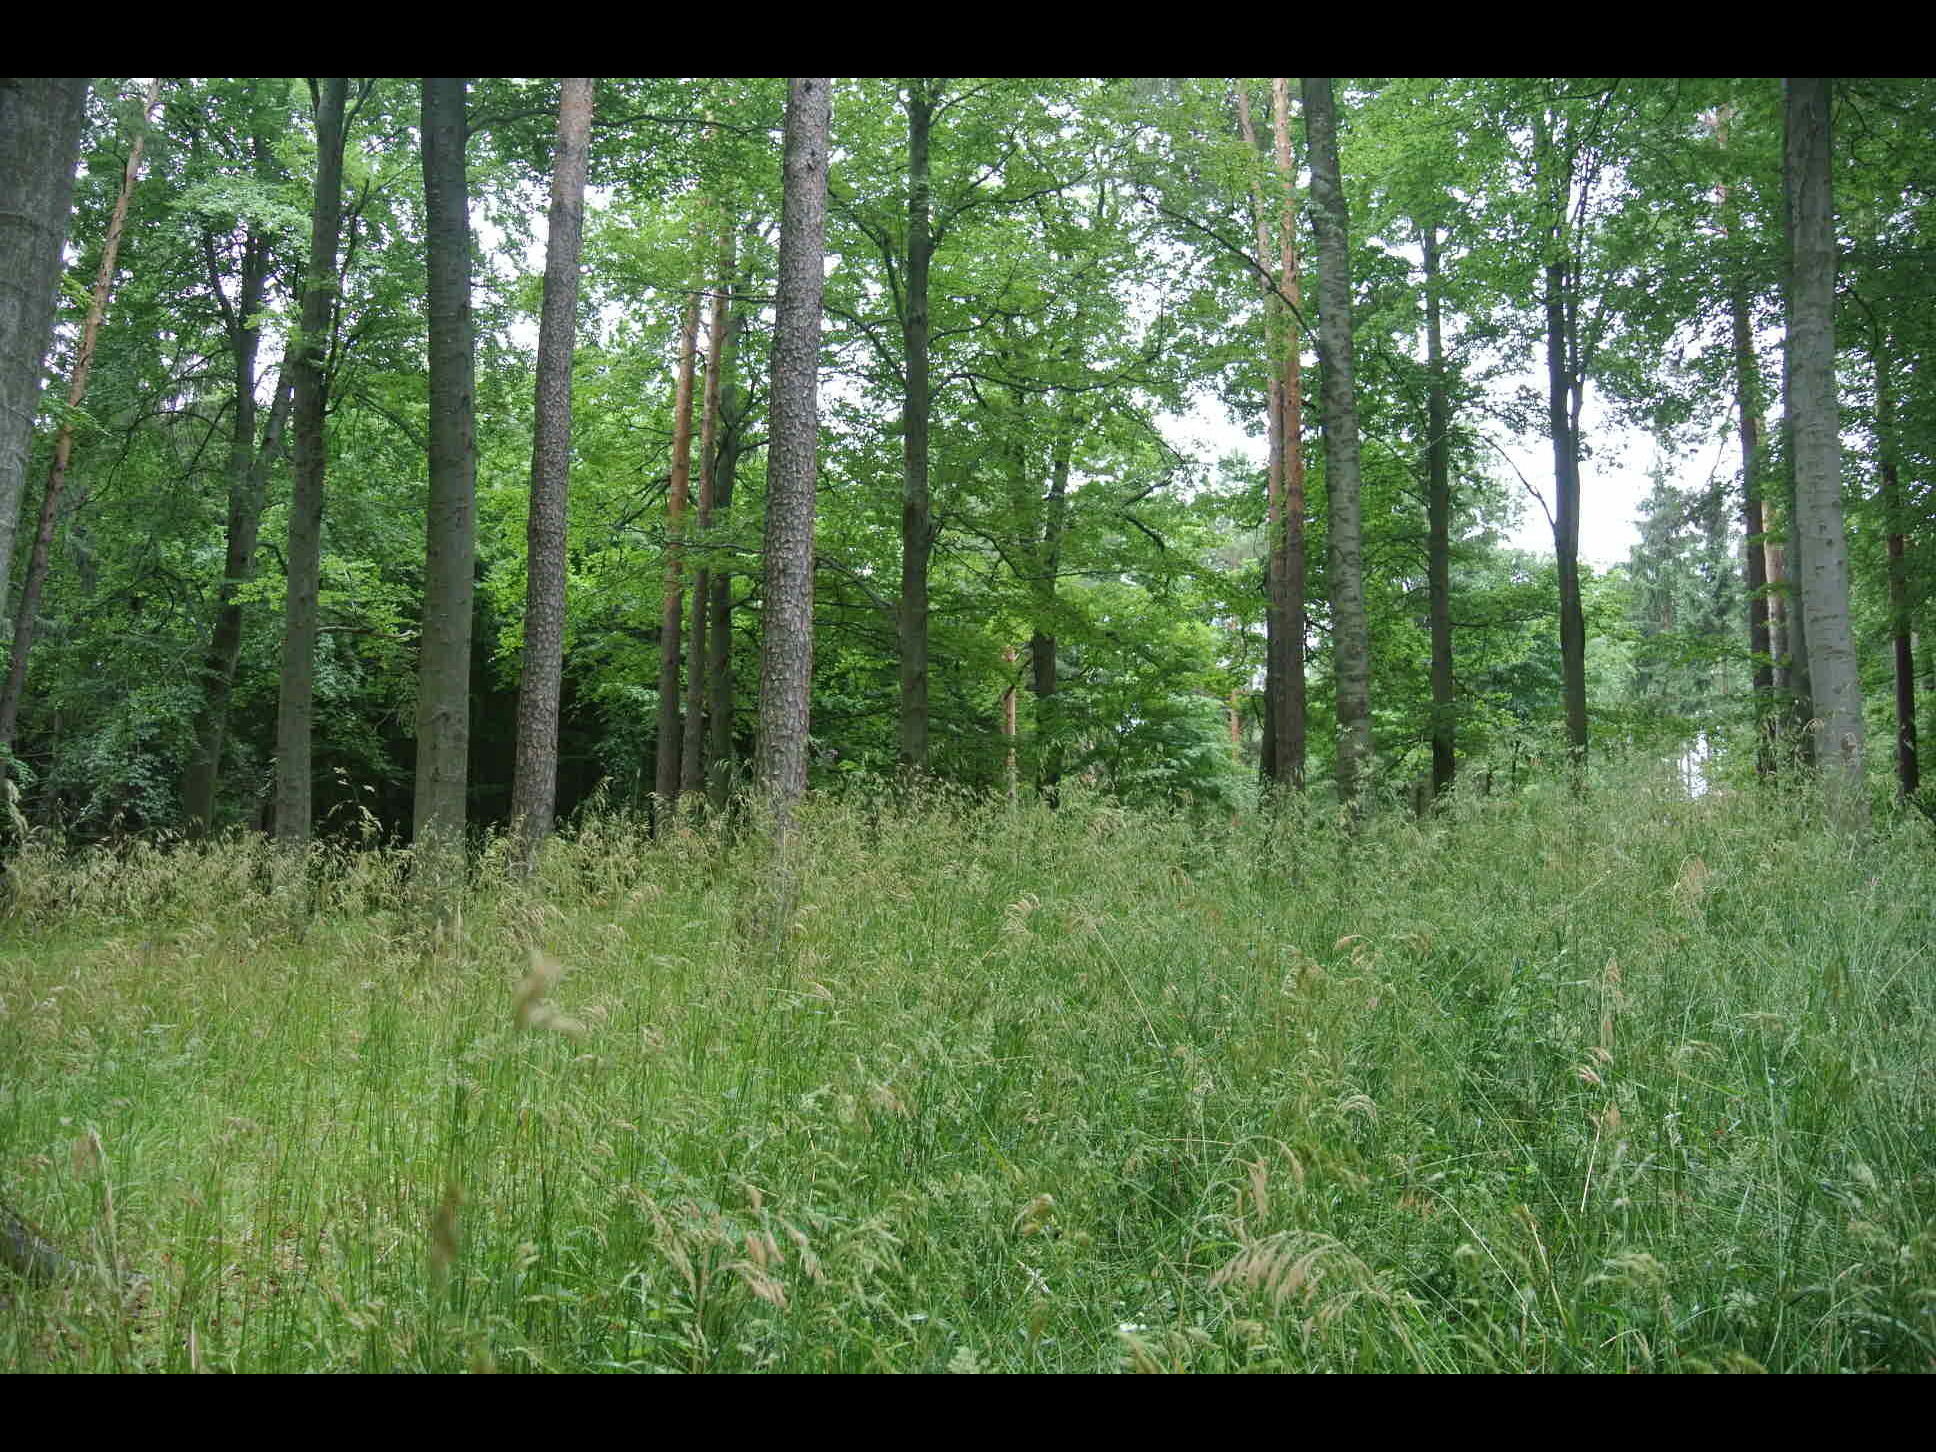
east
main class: Woodland
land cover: Pine dominated mixed woodland
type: alpine coniferous forest
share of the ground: > 75 %
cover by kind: broadleaved forest trees 45 %, coniferous forest trees 35 %, herbaceous plants 20 %
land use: Forestry
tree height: > 5 m
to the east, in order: Pine dominated mixed woodland; Tracks; Spruce dominated mixed woodland; Pine dominated coniferous woodland
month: July
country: AT
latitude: 47.6400
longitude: 16.4062
